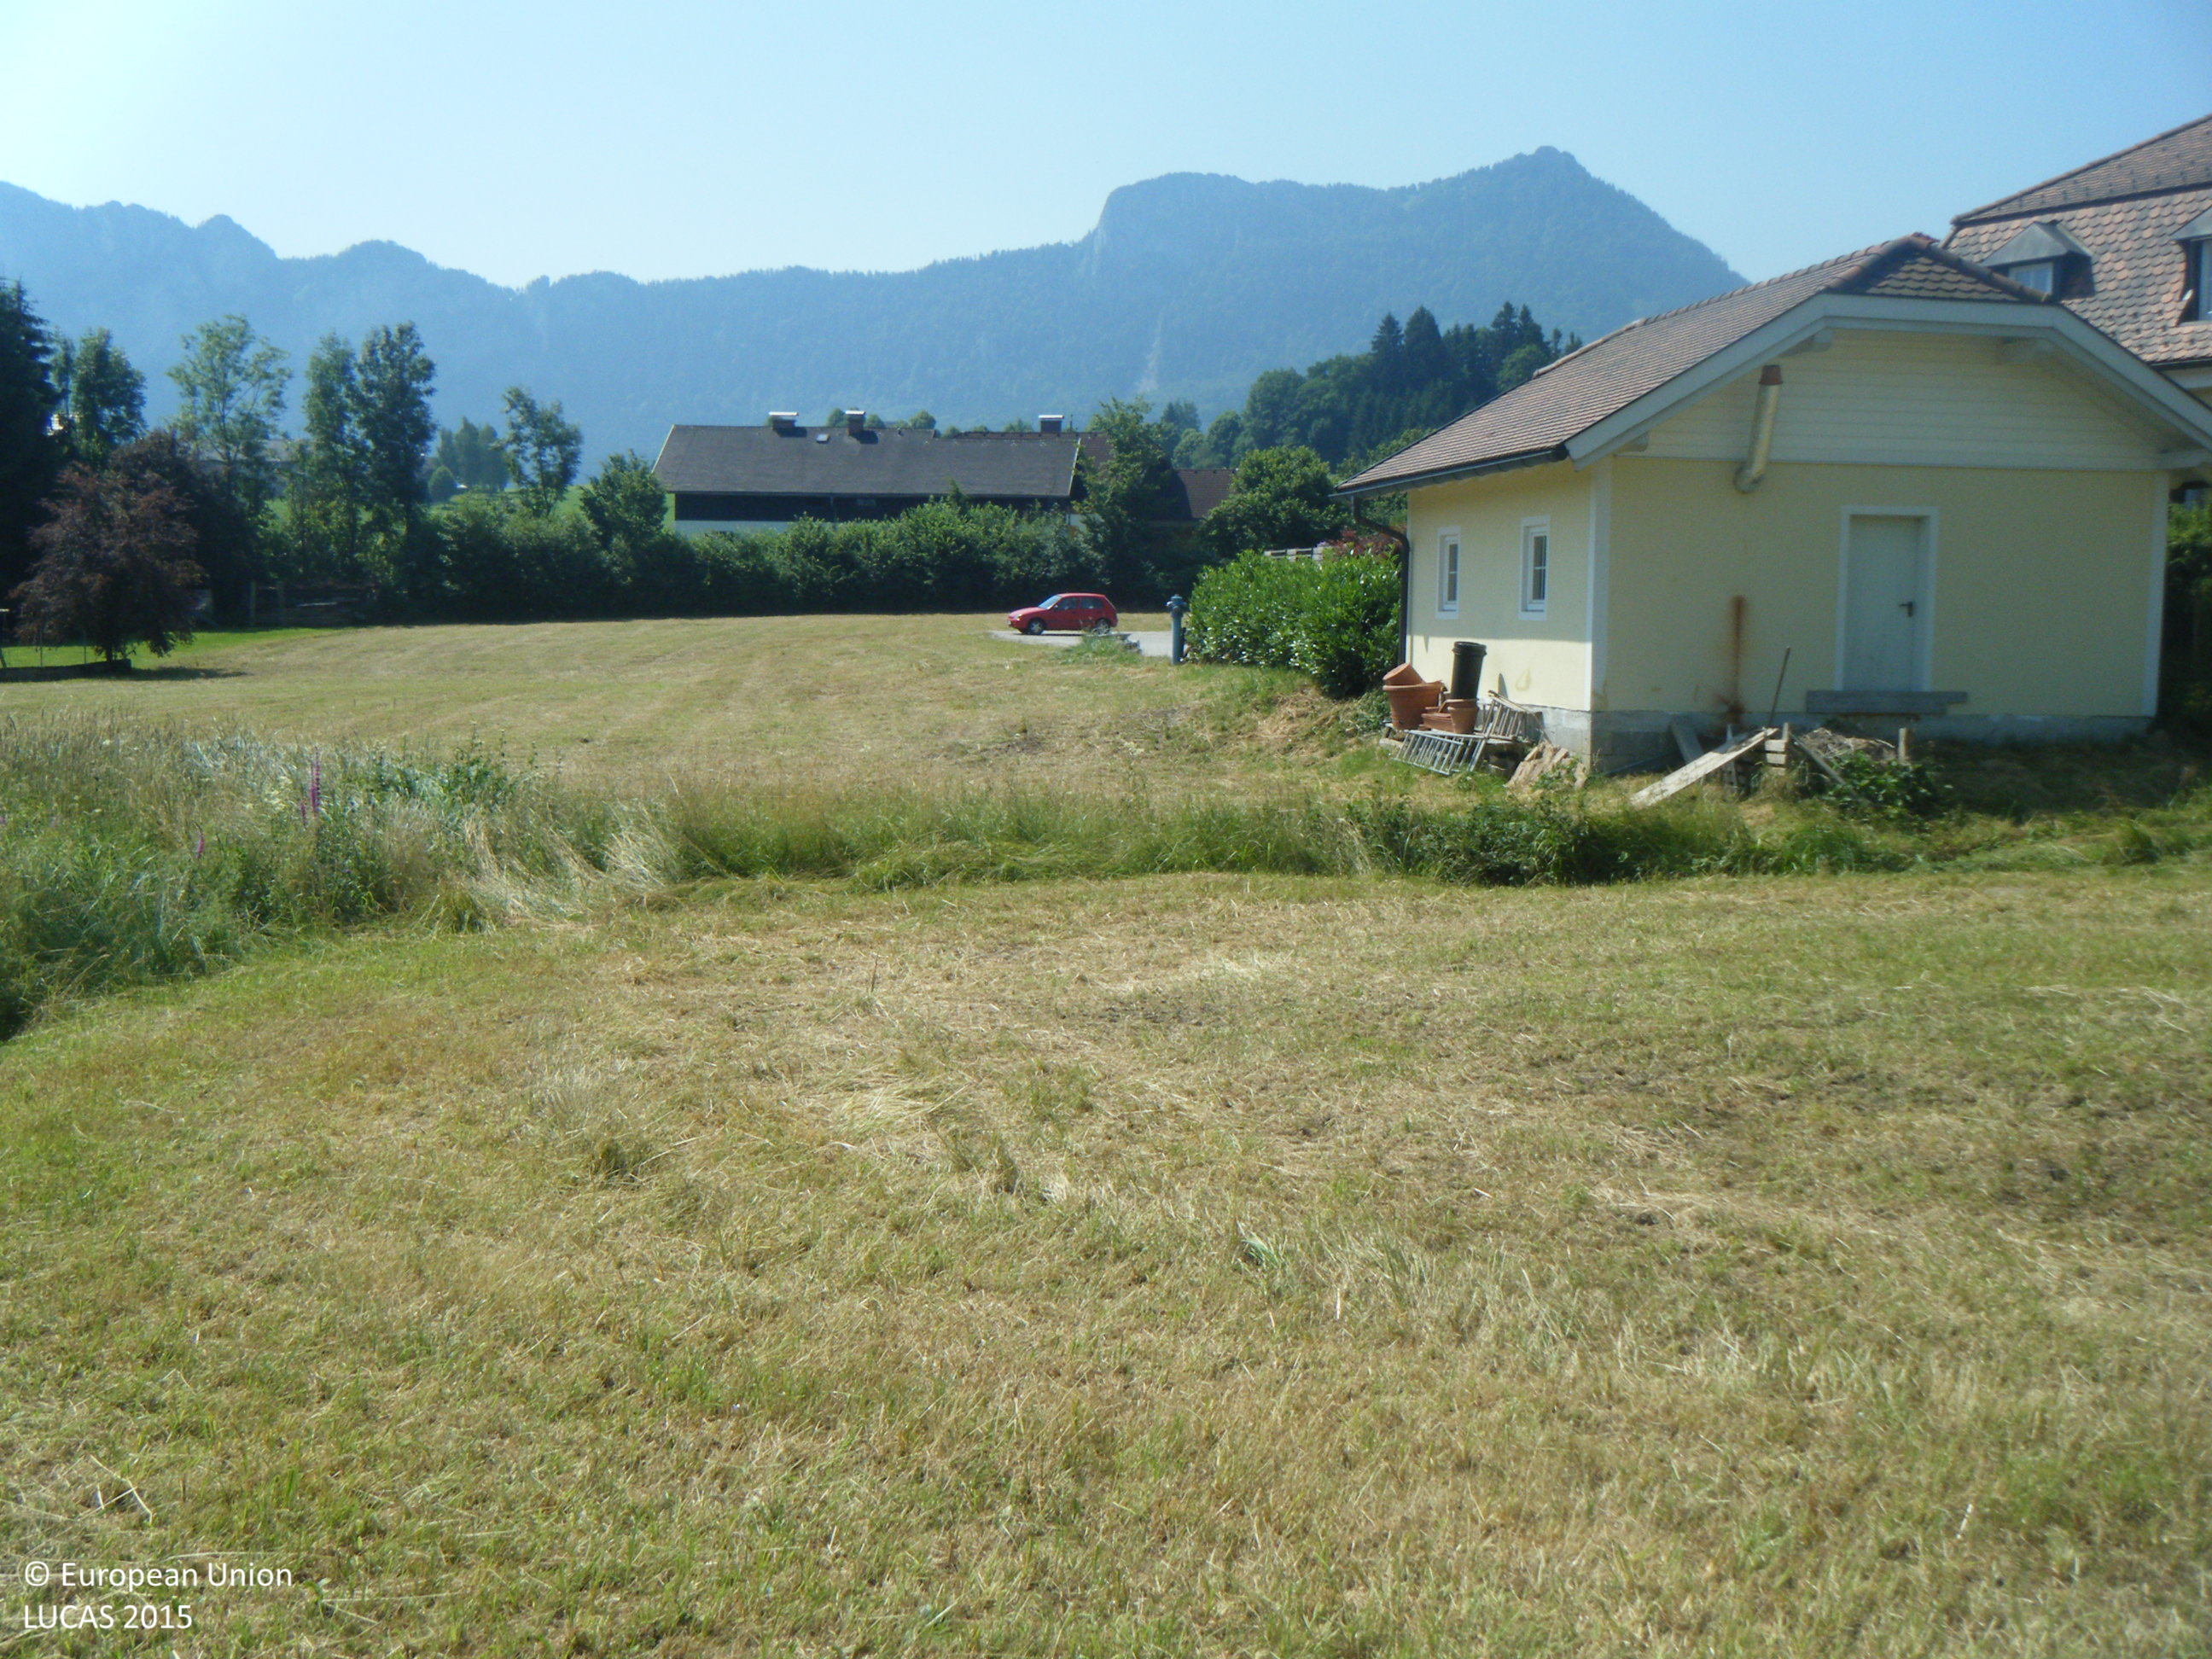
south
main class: Grassland
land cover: Grassland without tree/shrub cover
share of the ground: > 75 %
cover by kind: herbaceous plants 100 %
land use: Agriculture (excluding fallow land and kitchen gardens)
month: July
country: AT
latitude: 47.8492
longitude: 13.3263
